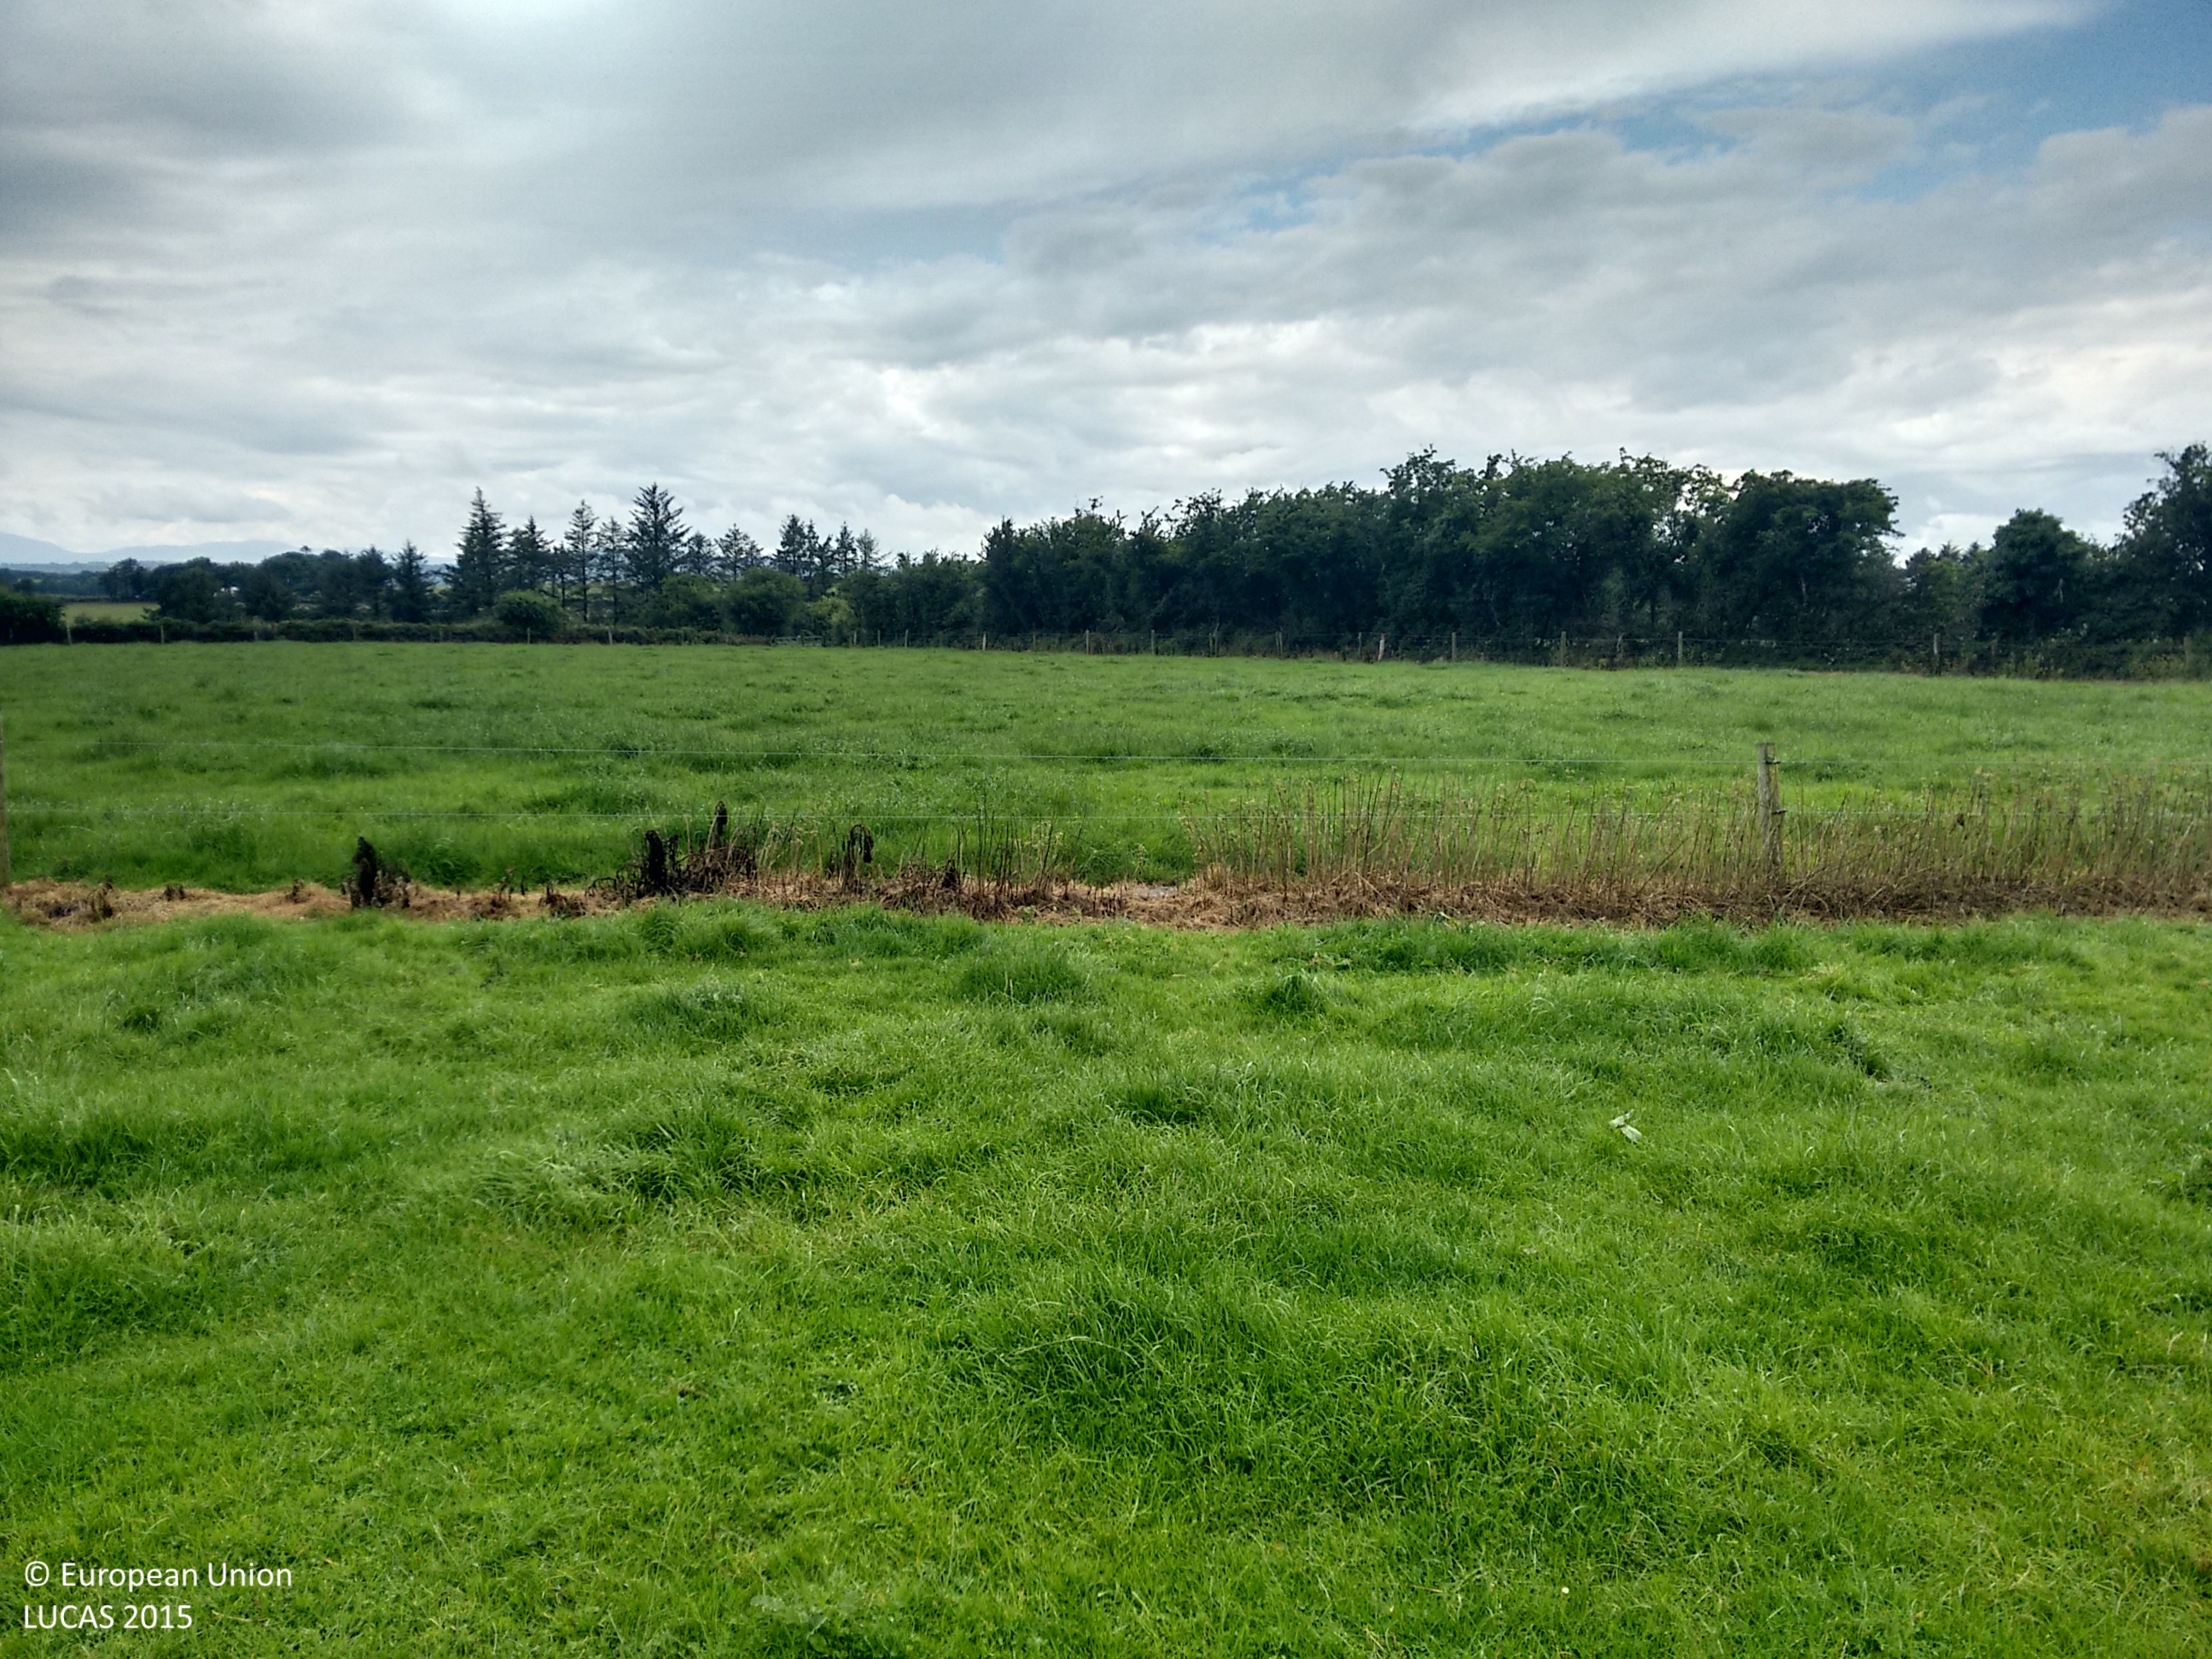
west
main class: Grassland
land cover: Grassland without tree/shrub cover
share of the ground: > 75 %
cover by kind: herbaceous plants 100 %
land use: Agriculture (excluding fallow land and kitchen gardens)
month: July
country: IE
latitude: 52.4382
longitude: -7.1679
